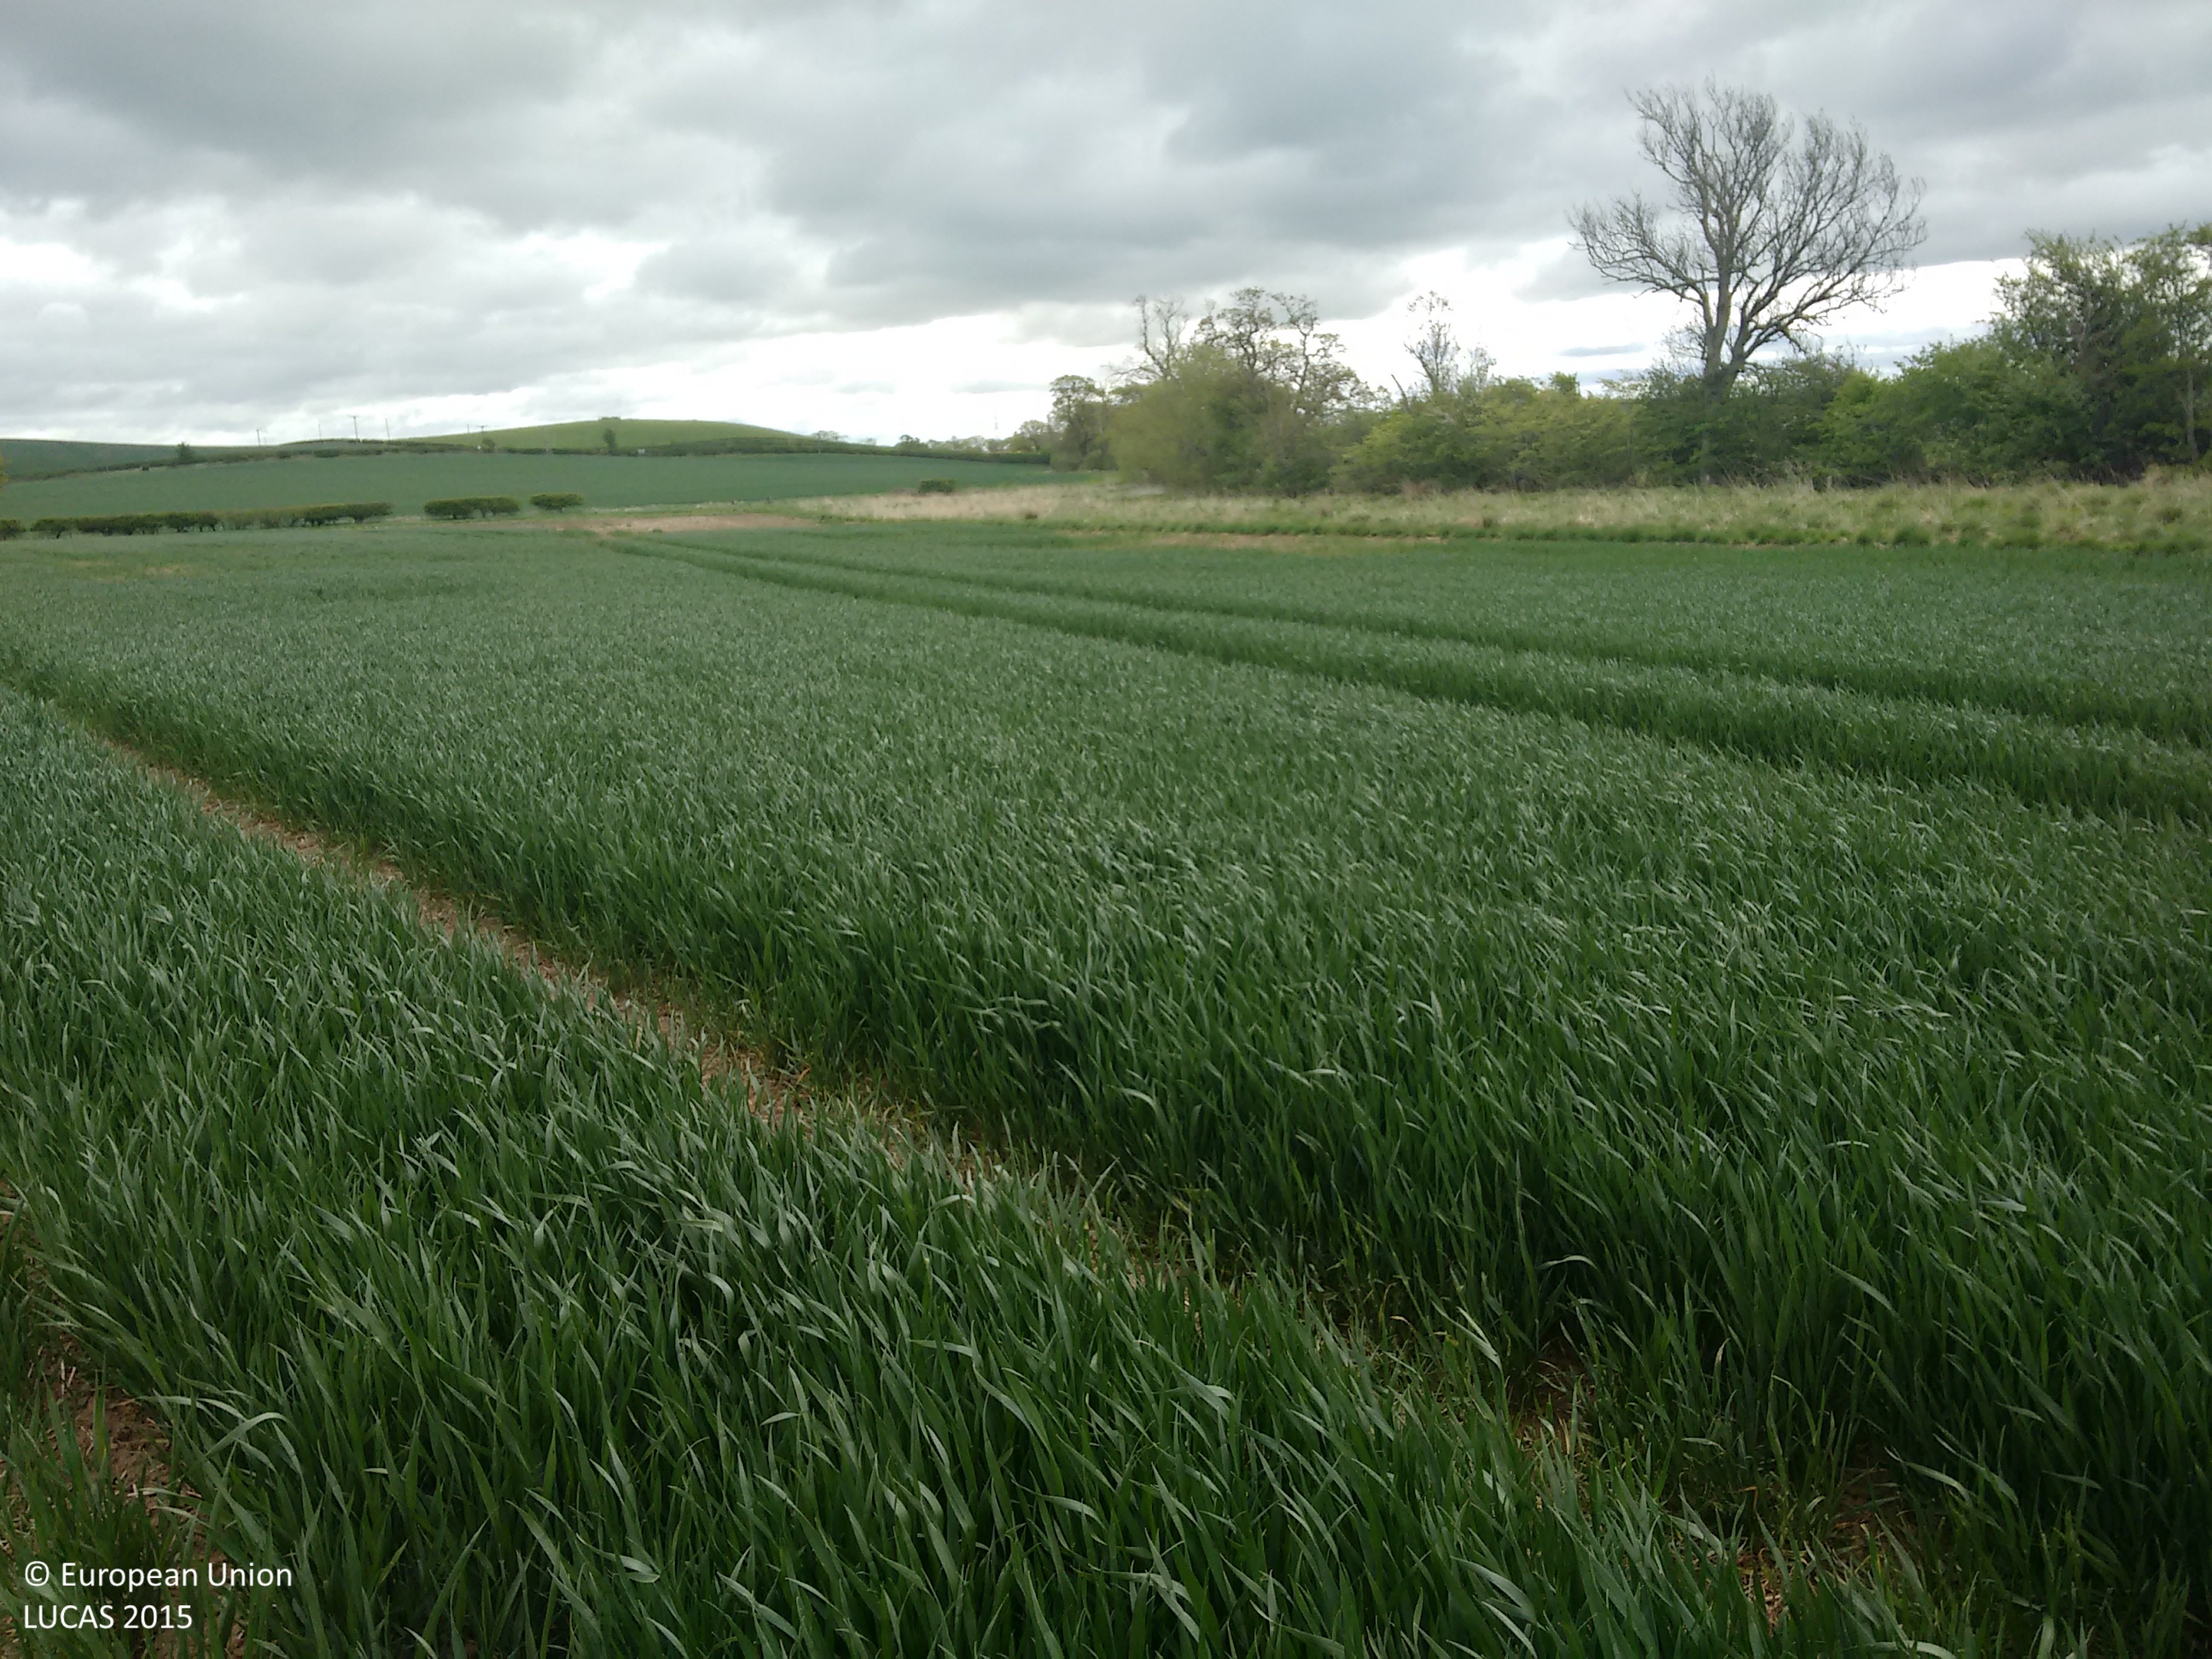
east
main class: Cropland
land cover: Common wheat
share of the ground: > 75 %
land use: Agriculture (excluding fallow land and kitchen gardens)
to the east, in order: Common wheat; Grass margins; Fences; Managed hedges; Barley
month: May
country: GB
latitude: 55.7299
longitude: -2.2053
